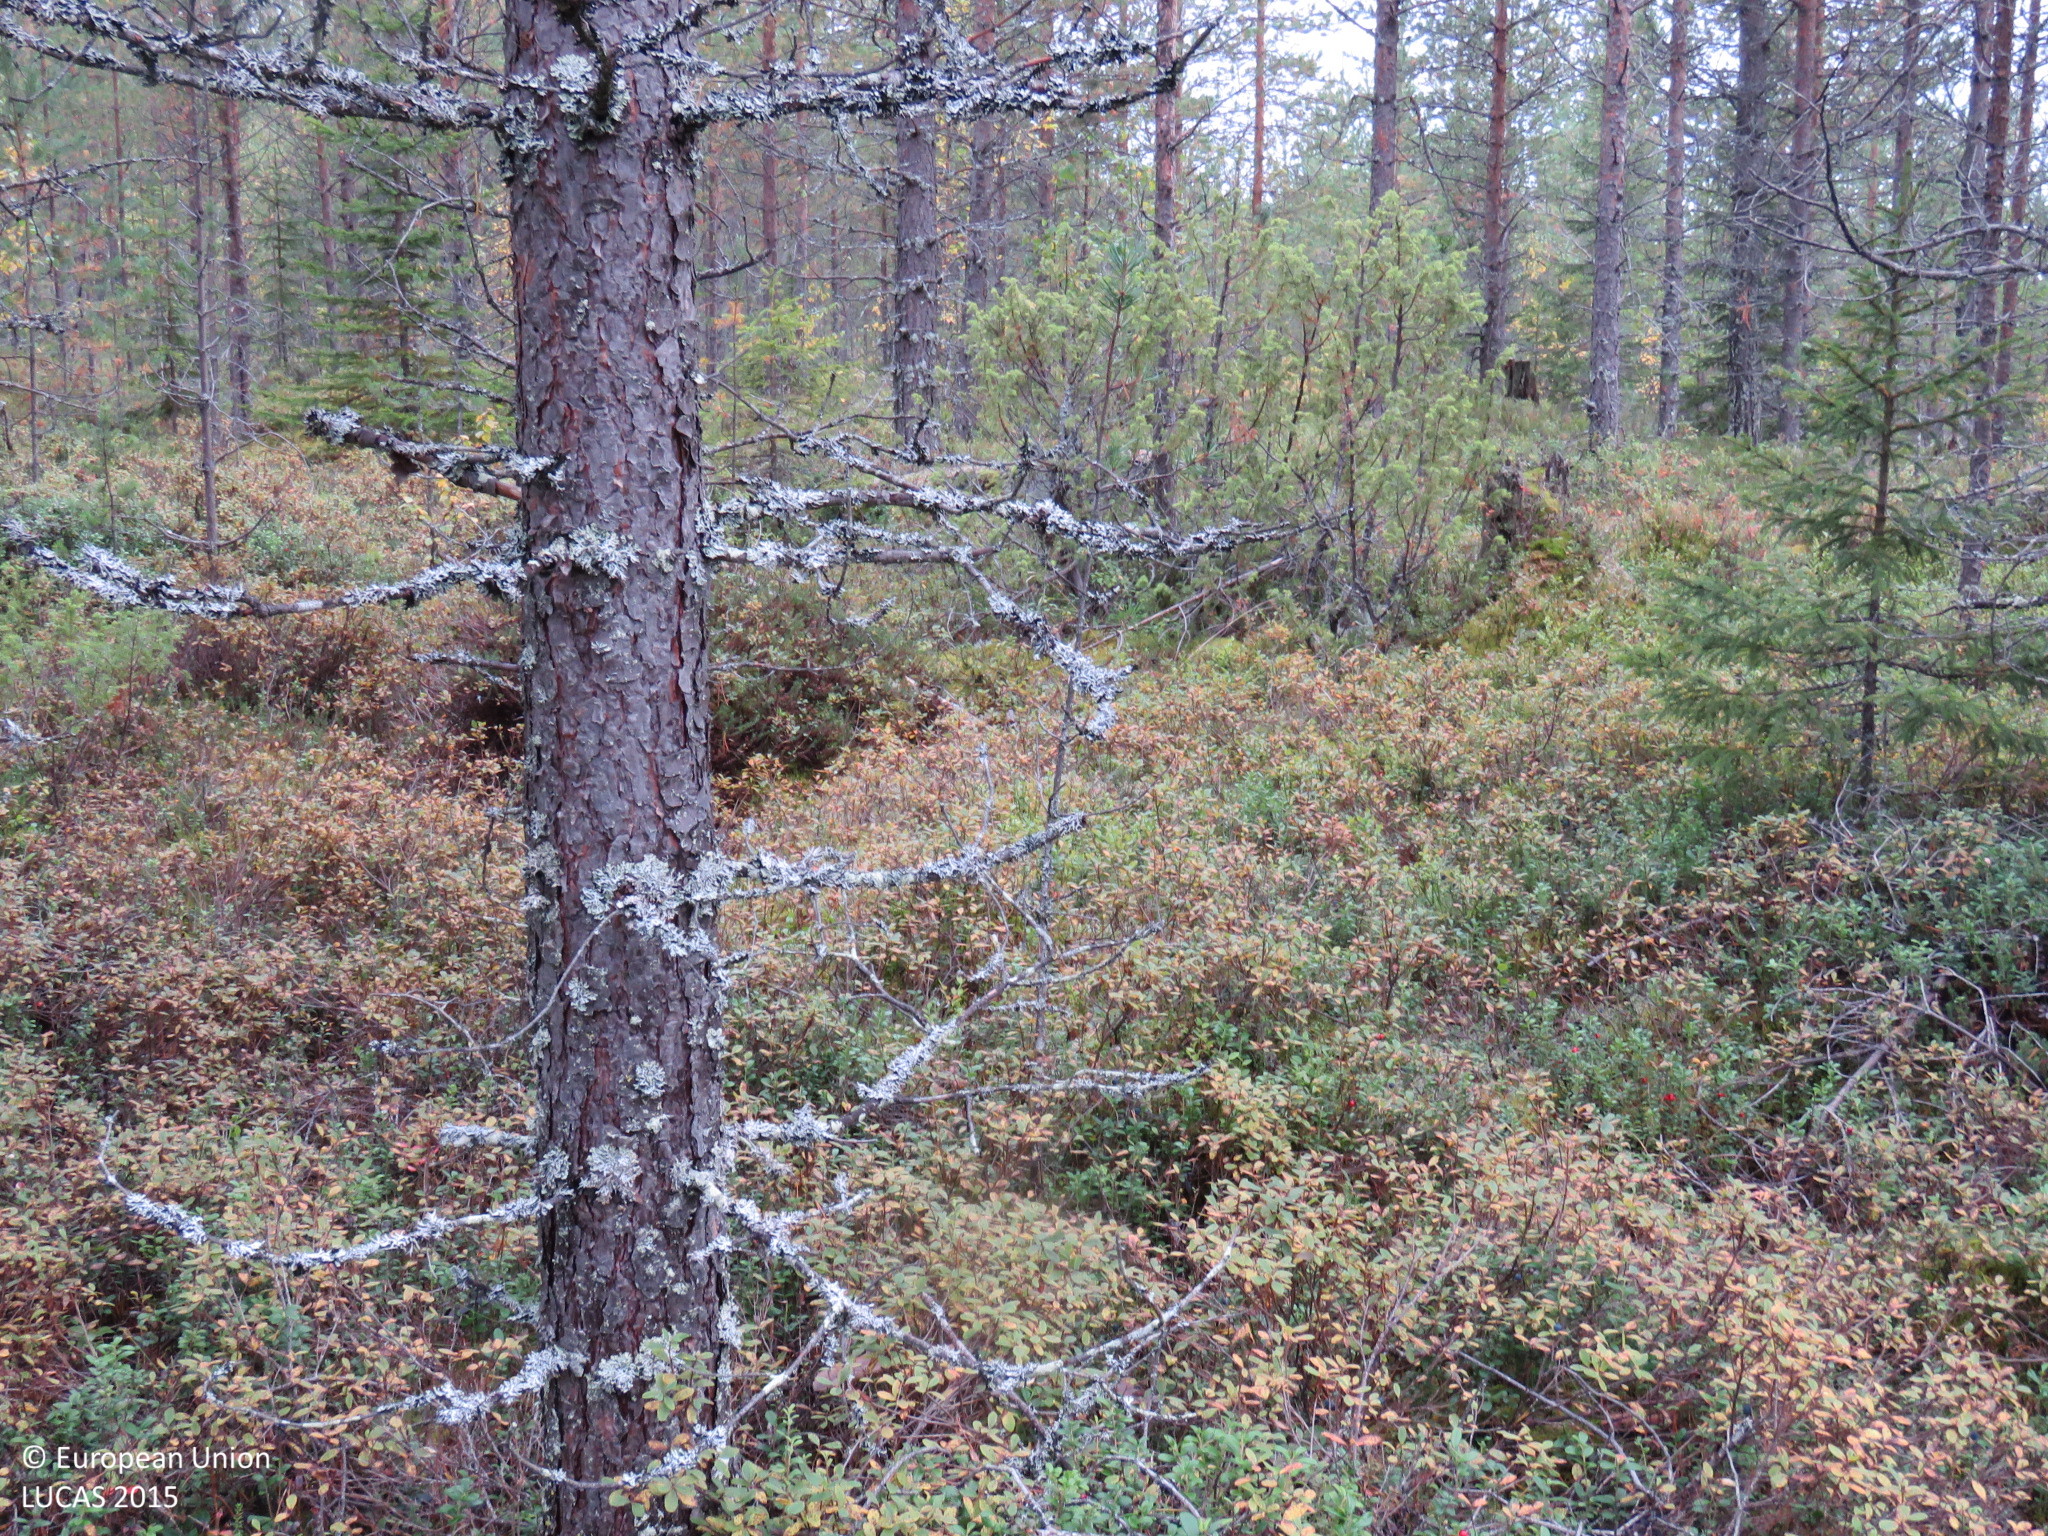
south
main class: Woodland
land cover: Other coniferous woodland
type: boreal forest
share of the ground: > 75 %
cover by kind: coniferous forest trees 75 %, shrubs 15 %, broadleaved forest trees 5 %, lichens and mosses 5 %
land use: Forestry
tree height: > 5 m
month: September
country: FI
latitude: 65.2266
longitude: 27.4340
